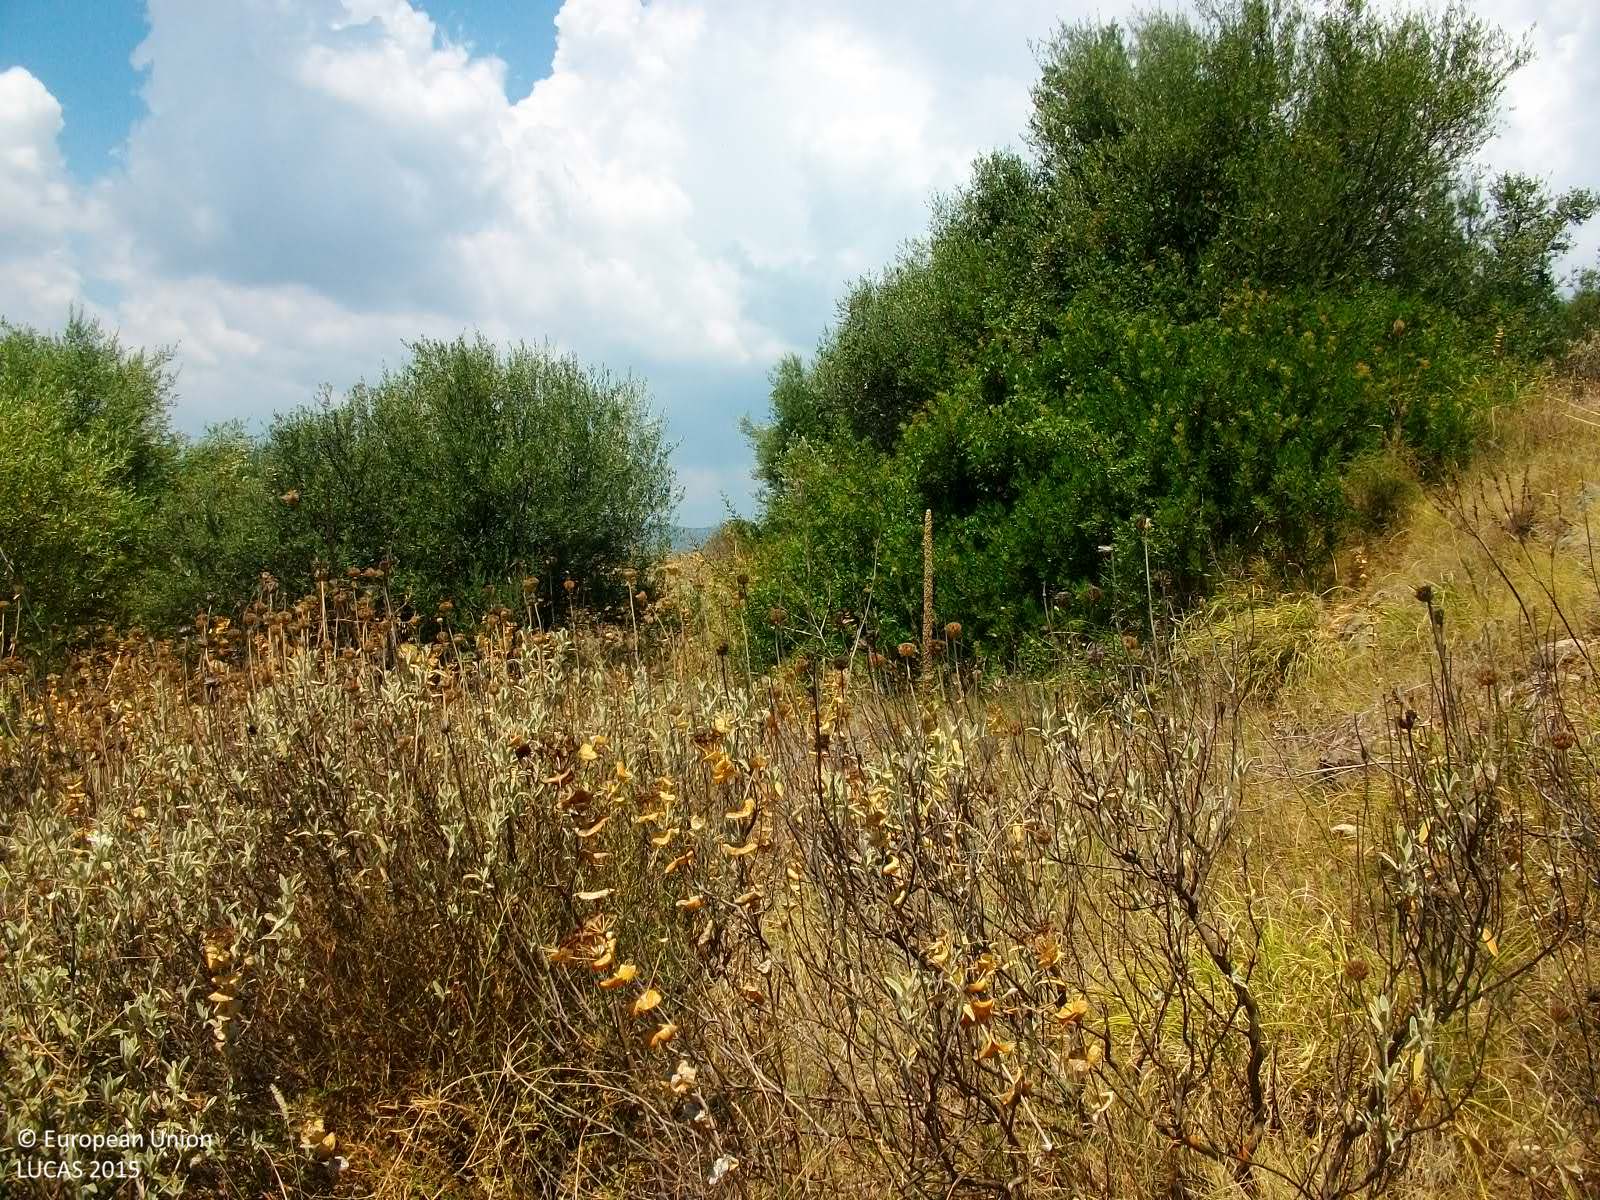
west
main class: Cropland
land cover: Olive groves
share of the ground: < 10 %
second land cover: Shrubland without tree cover
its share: 25 - 50 %
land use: Agriculture (excluding fallow land and kitchen gardens)
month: July
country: GR
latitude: 37.1771
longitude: 21.9273
